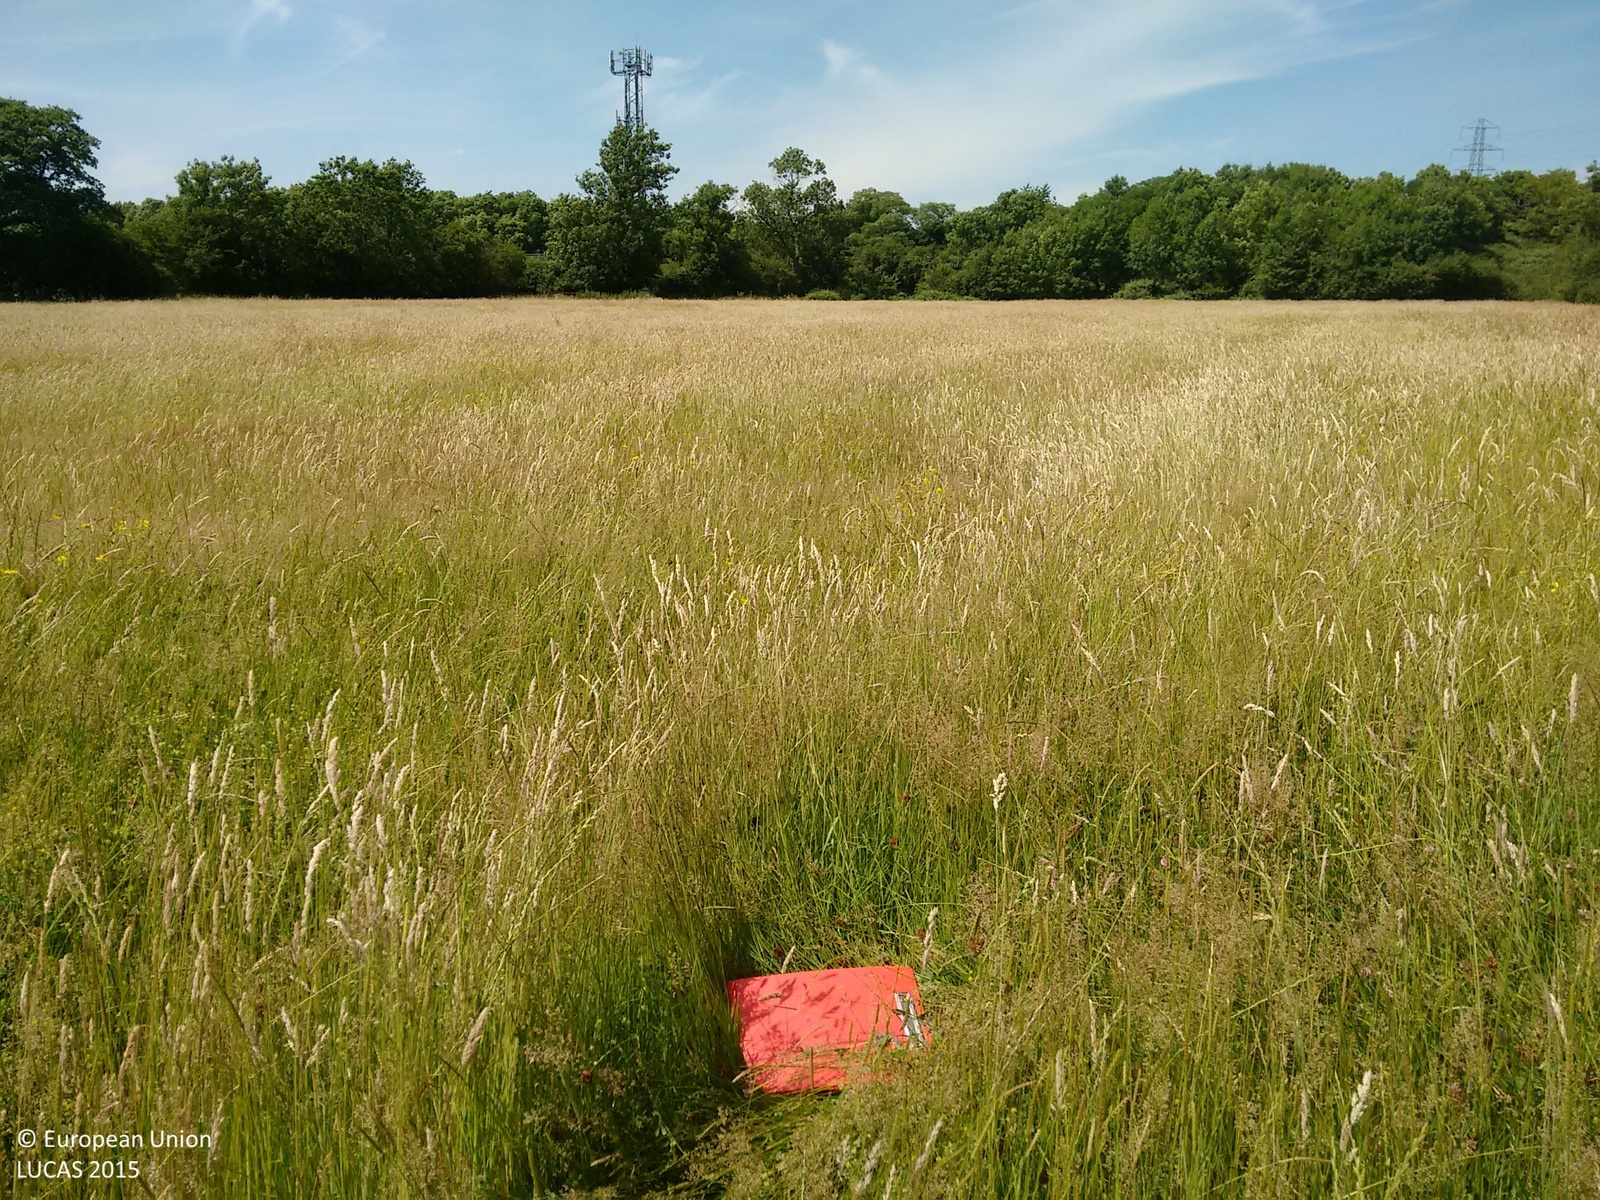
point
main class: Grassland
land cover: Grassland without tree/shrub cover
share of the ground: > 75 %
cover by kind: herbaceous plants 100 %
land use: Agriculture (excluding fallow land and kitchen gardens)
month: July
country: GB
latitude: 52.4417
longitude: -1.4217
